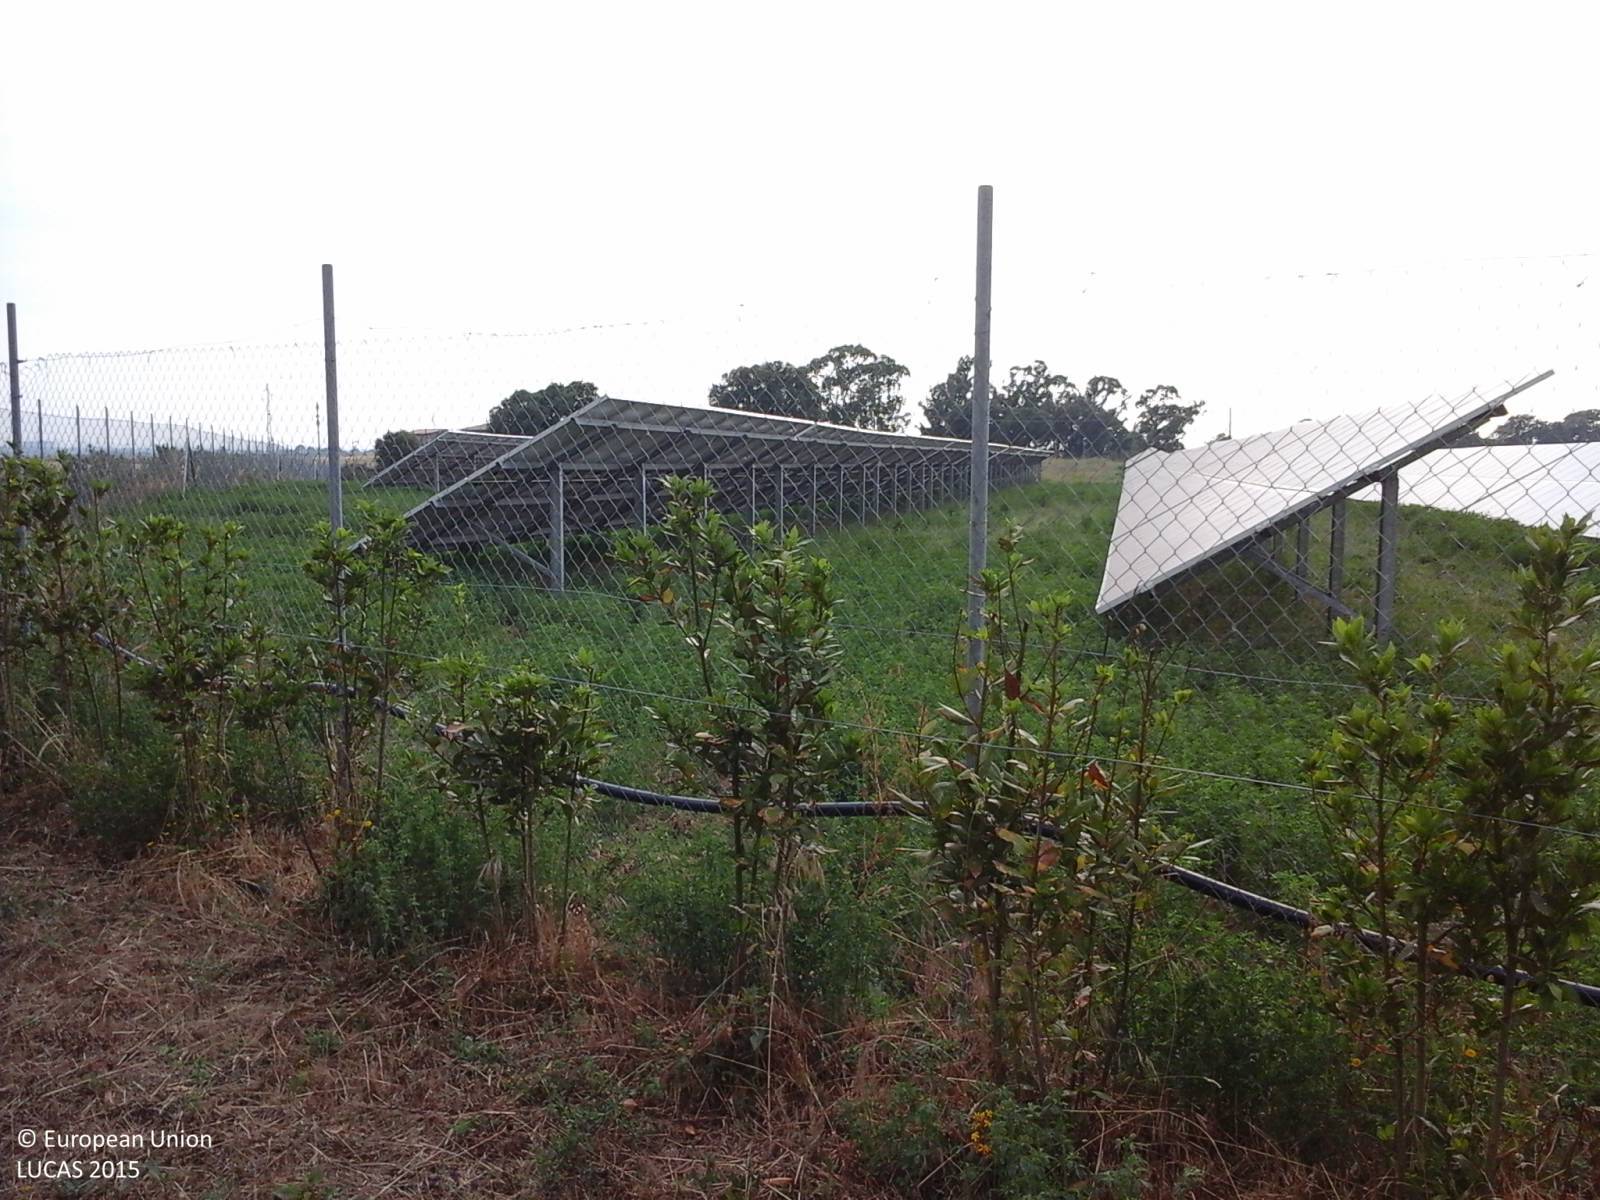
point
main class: Cropland
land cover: Lucerne
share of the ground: > 75 %
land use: Agriculture (excluding fallow land and kitchen gardens)
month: June
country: IT
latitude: 42.4064
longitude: 11.6104
